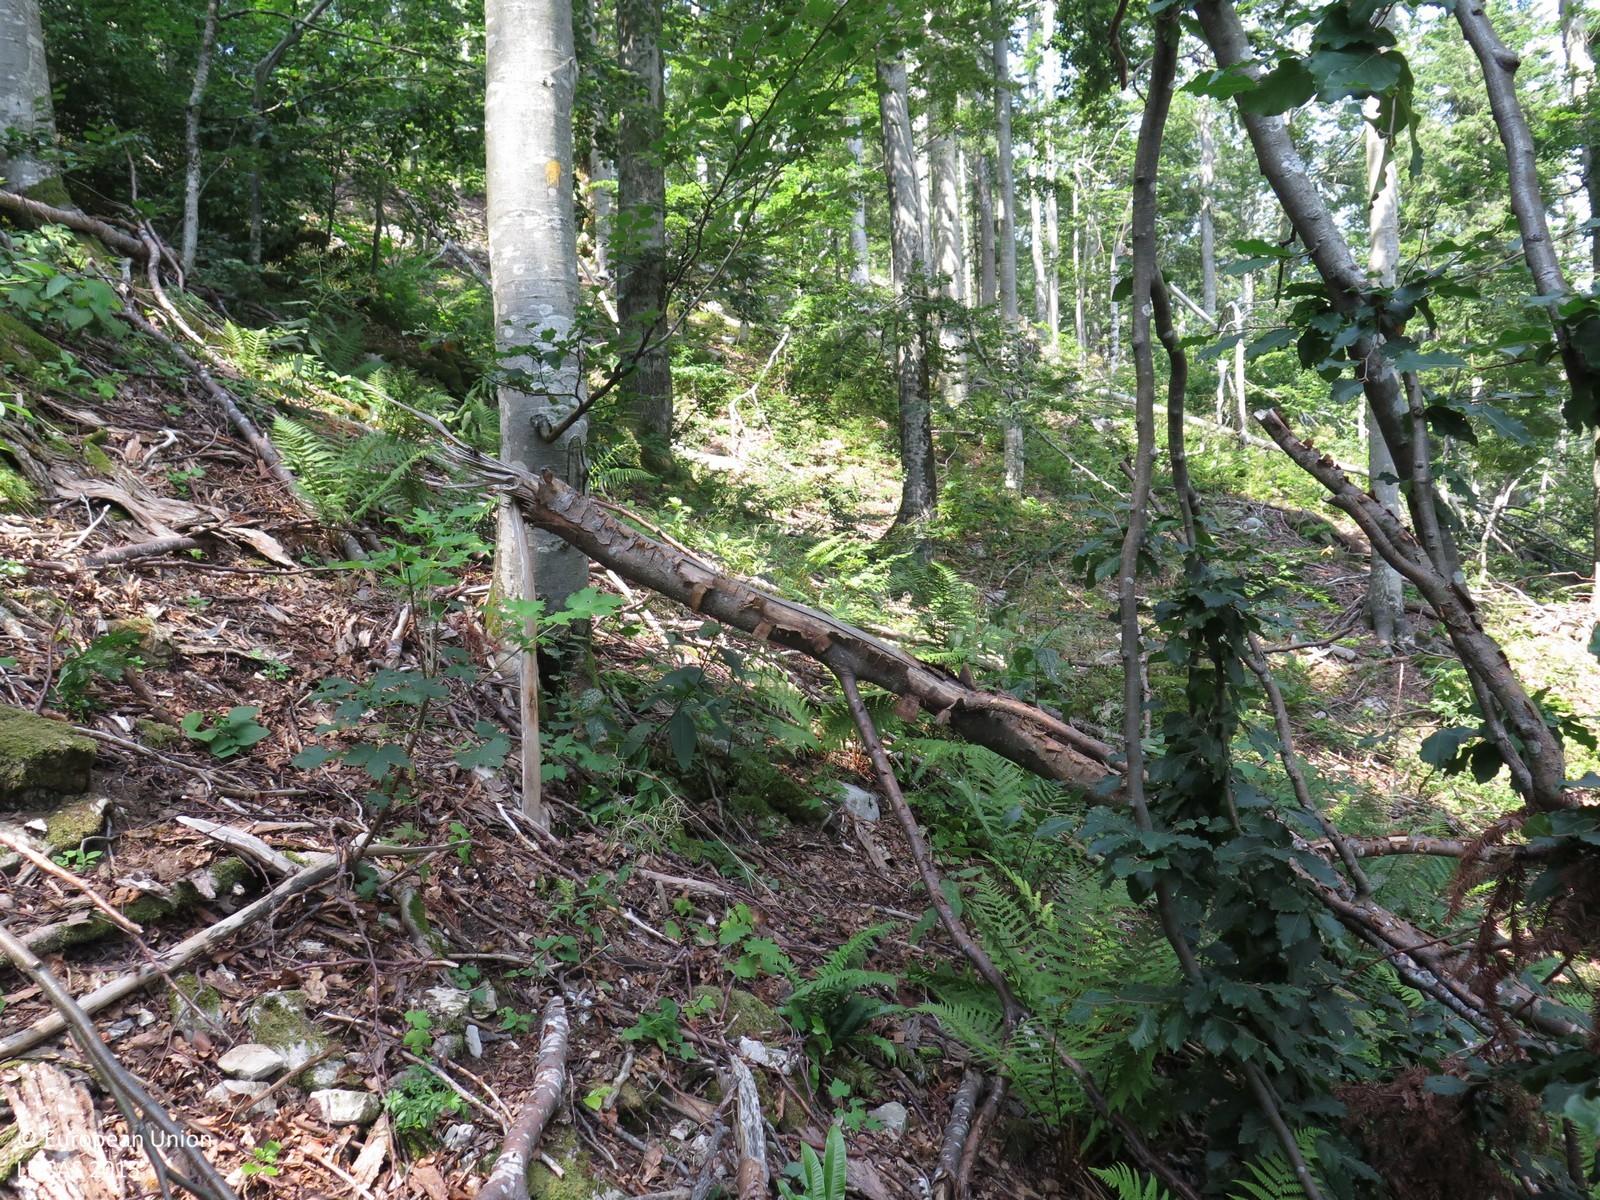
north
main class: Woodland
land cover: Broadleaved woodland
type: mountainous beech forest
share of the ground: > 75 %
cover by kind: broadleaved forest trees 95 %, herbaceous plants 5 %
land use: Forestry
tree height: > 5 m
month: August
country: HR
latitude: 45.4949
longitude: 14.5893
